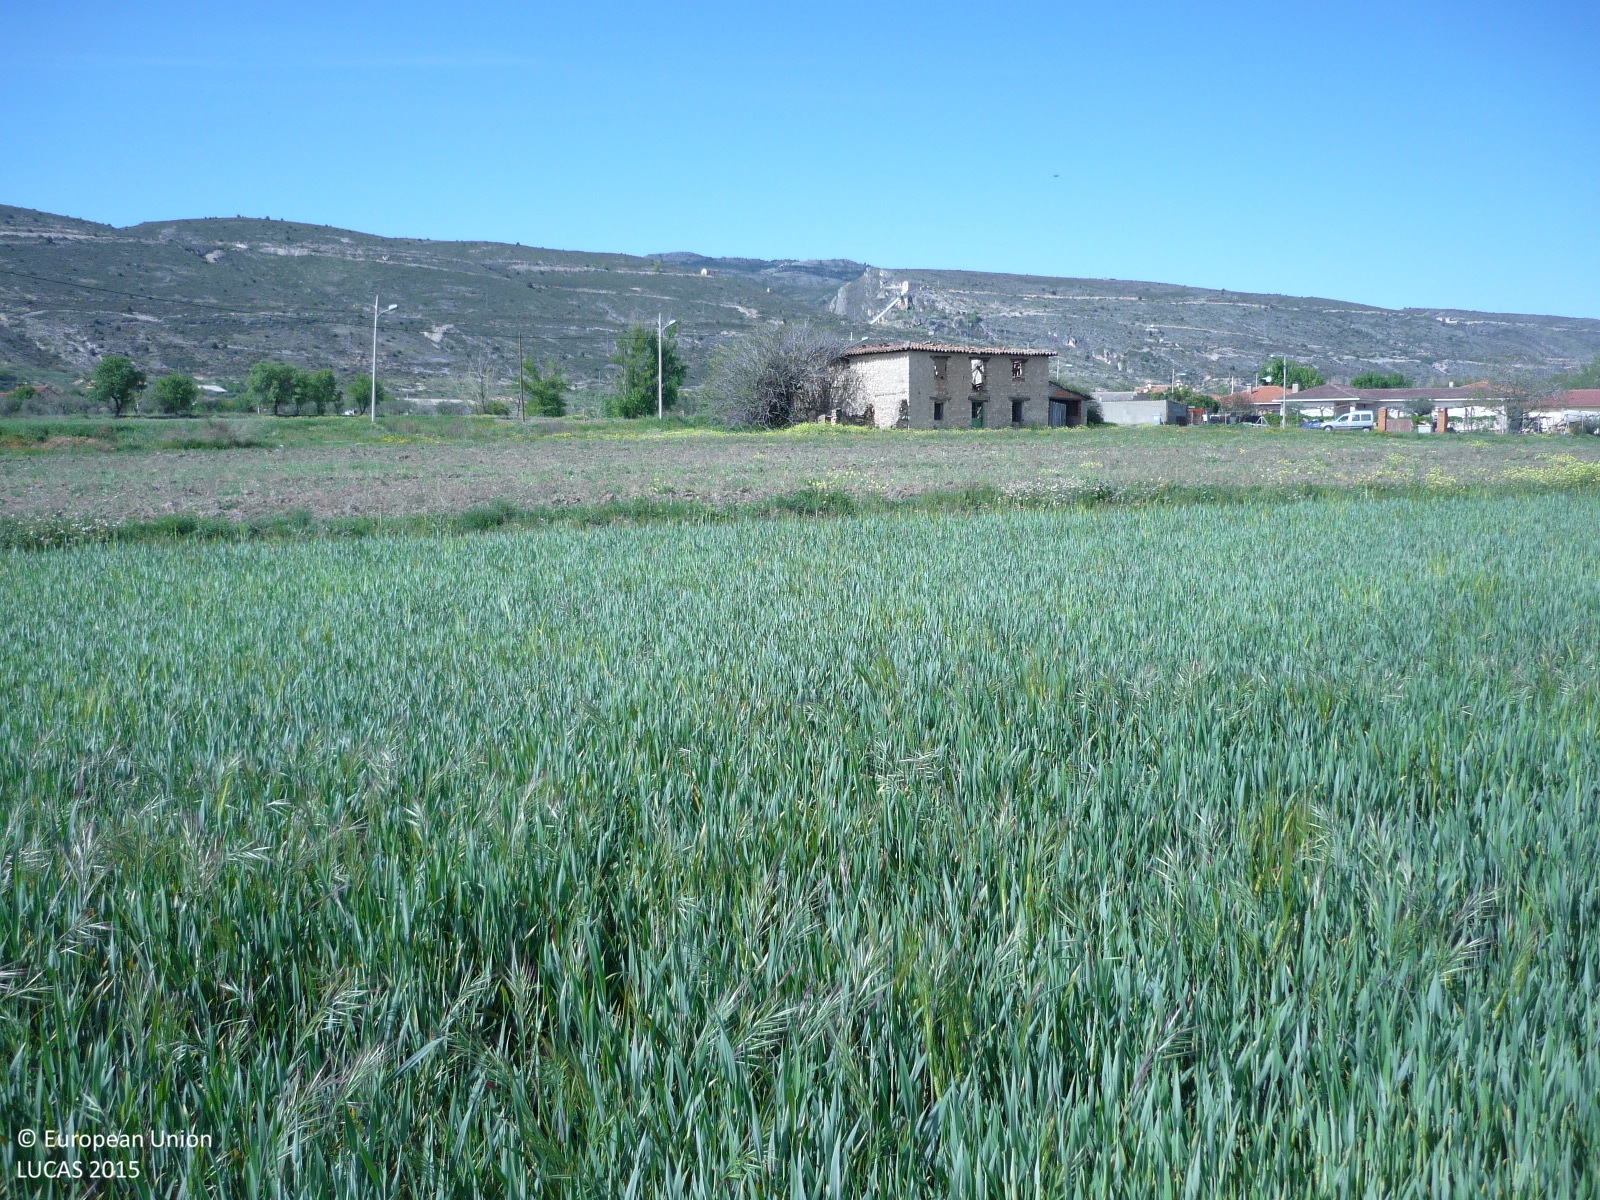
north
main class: Cropland
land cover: Common wheat
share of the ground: > 75 %
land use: Agriculture (excluding fallow land and kitchen gardens)
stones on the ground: < 10 %
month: April
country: ES
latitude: 40.8520
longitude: -3.4797
